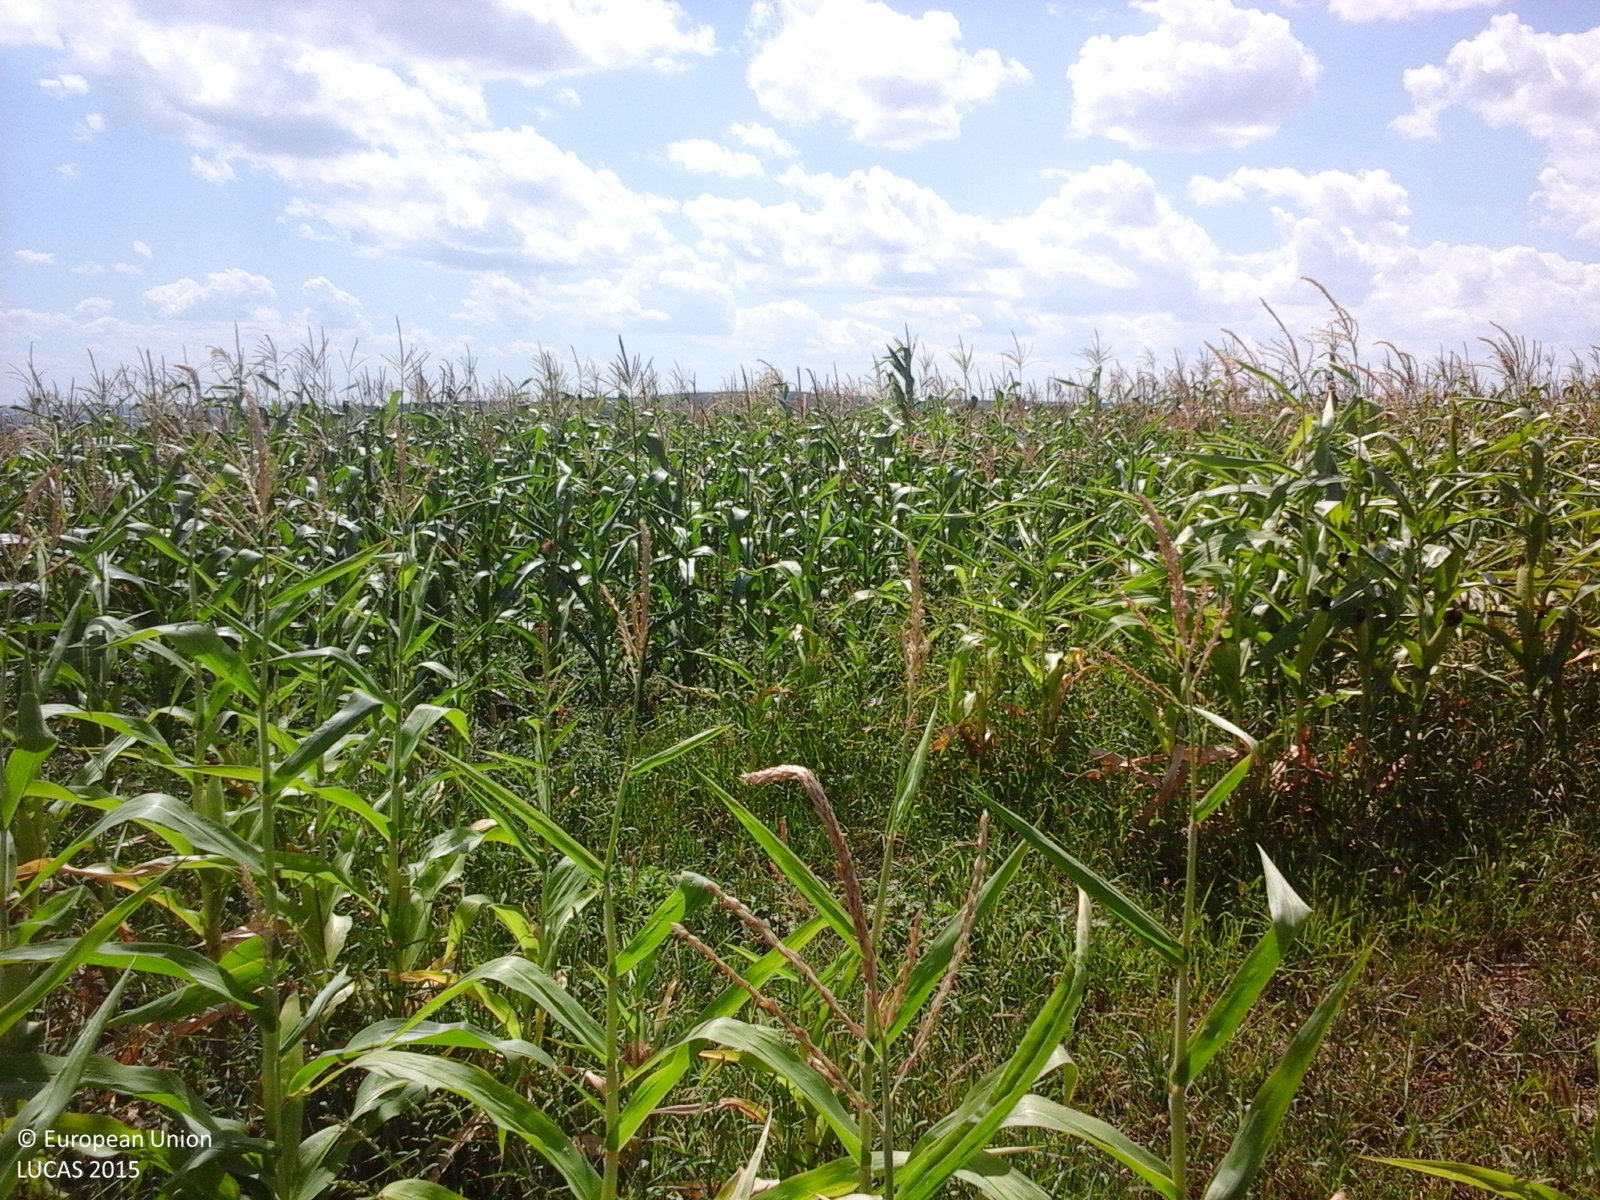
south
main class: Cropland
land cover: Maize
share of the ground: > 75 %
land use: Agriculture (excluding fallow land and kitchen gardens)
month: July
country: RO
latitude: 46.4269
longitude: 27.9115
